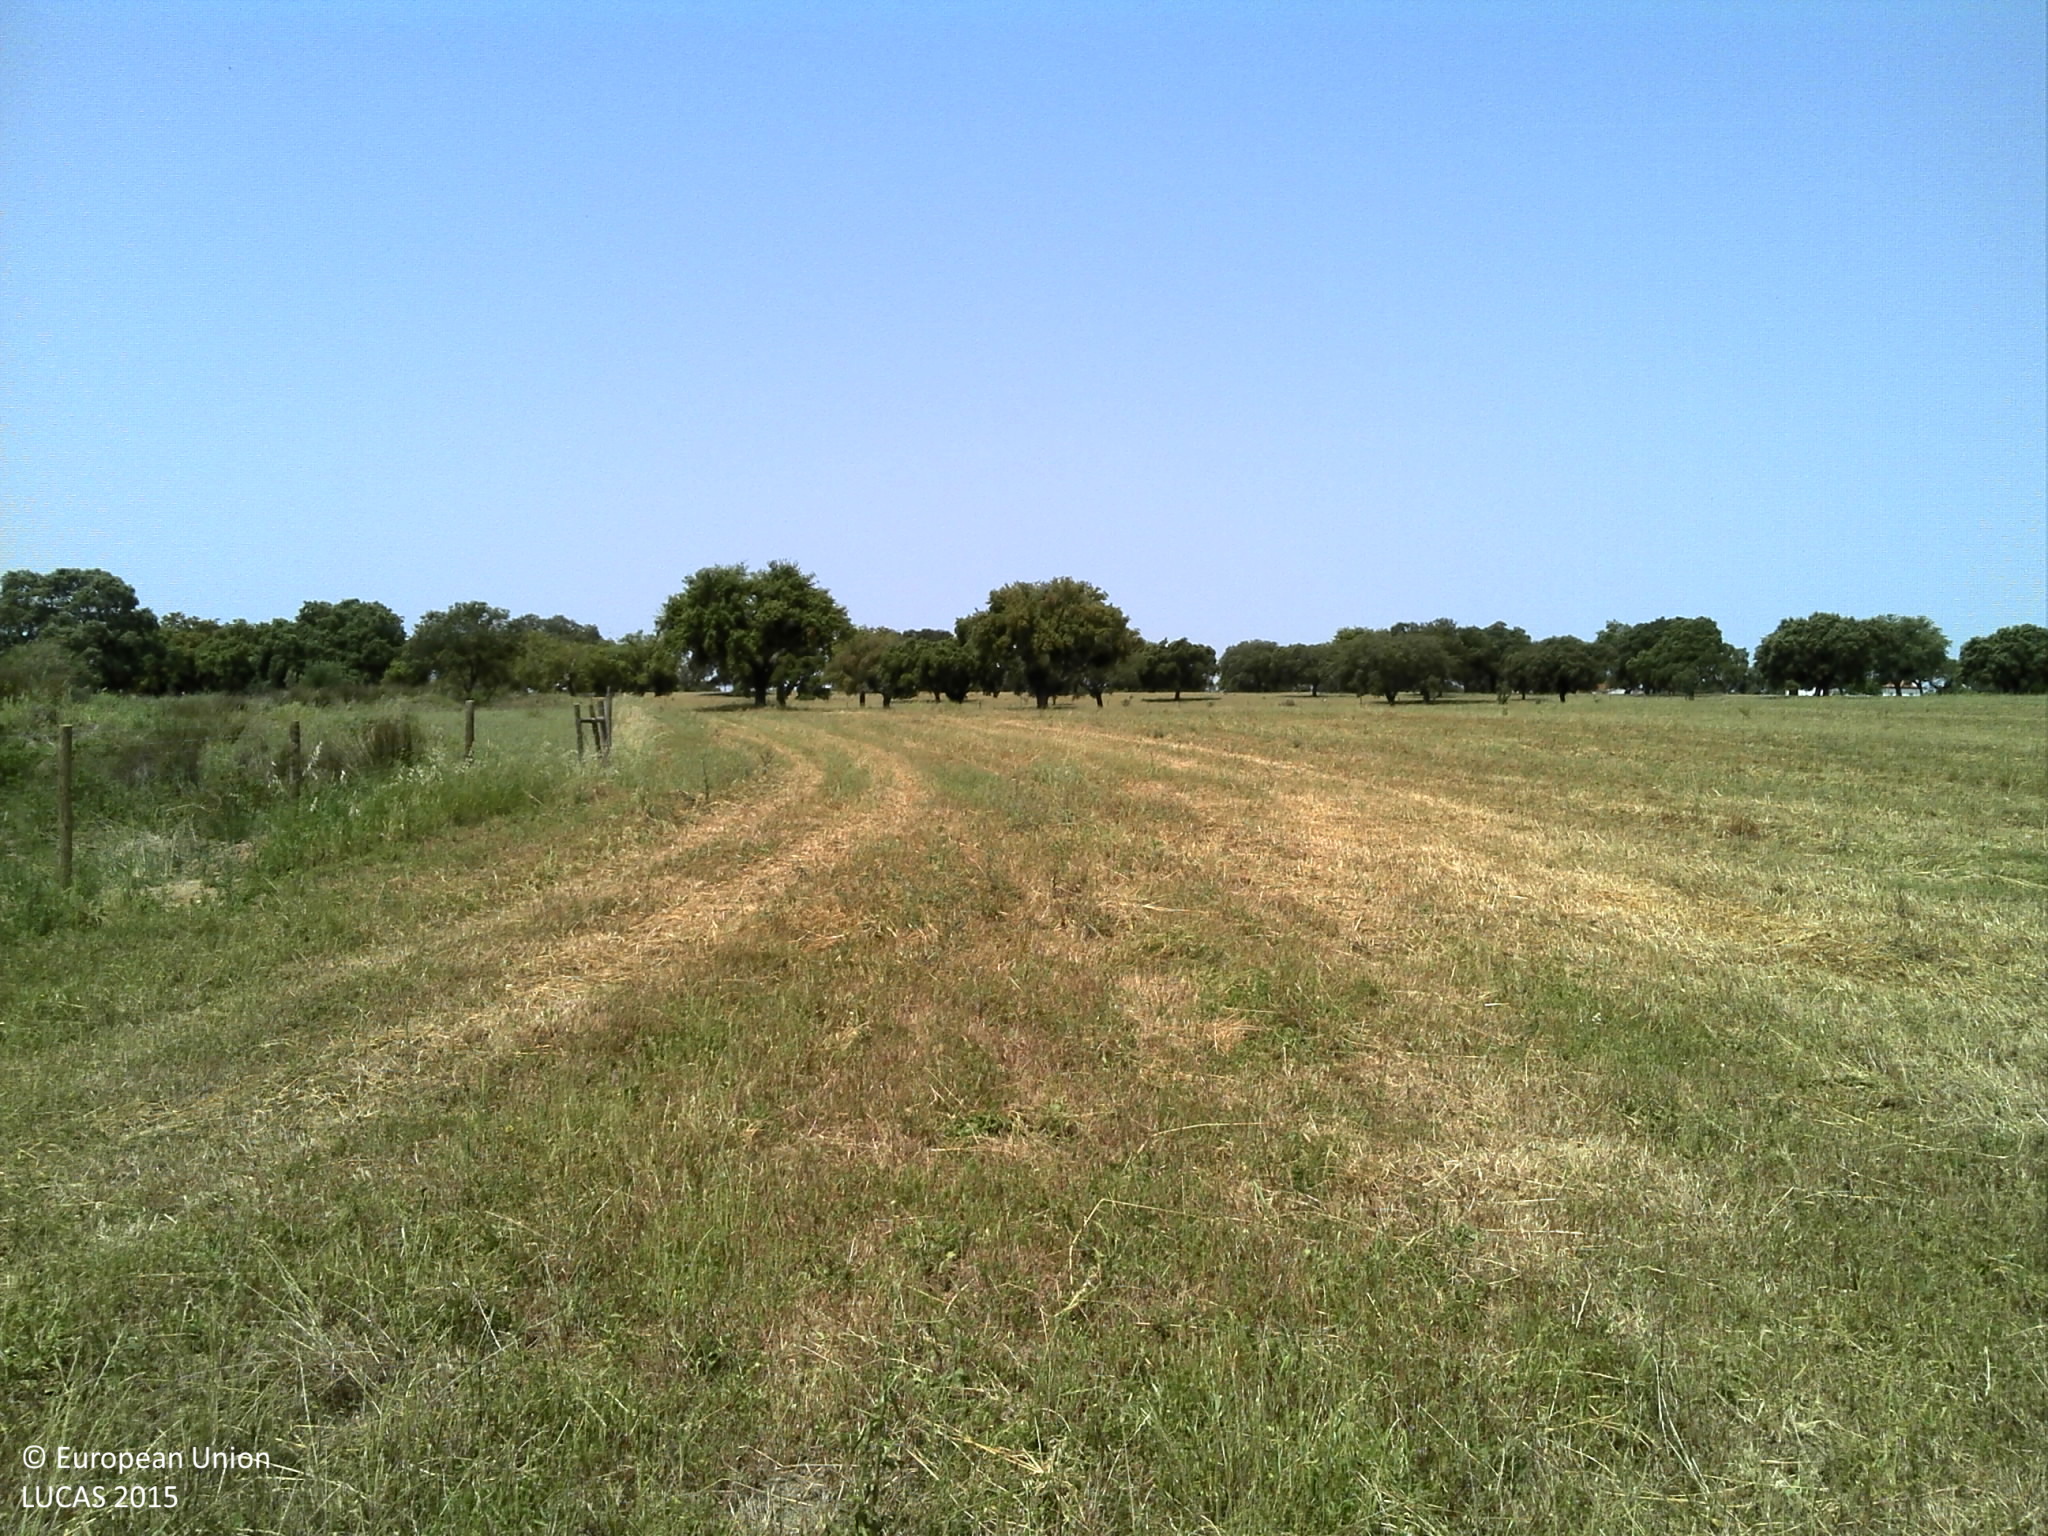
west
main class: Cropland
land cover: Oats
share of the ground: 50 - 75 %
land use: Agriculture (excluding fallow land and kitchen gardens)
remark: Harvested field
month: May
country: PT
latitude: 38.9616
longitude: -7.8761
